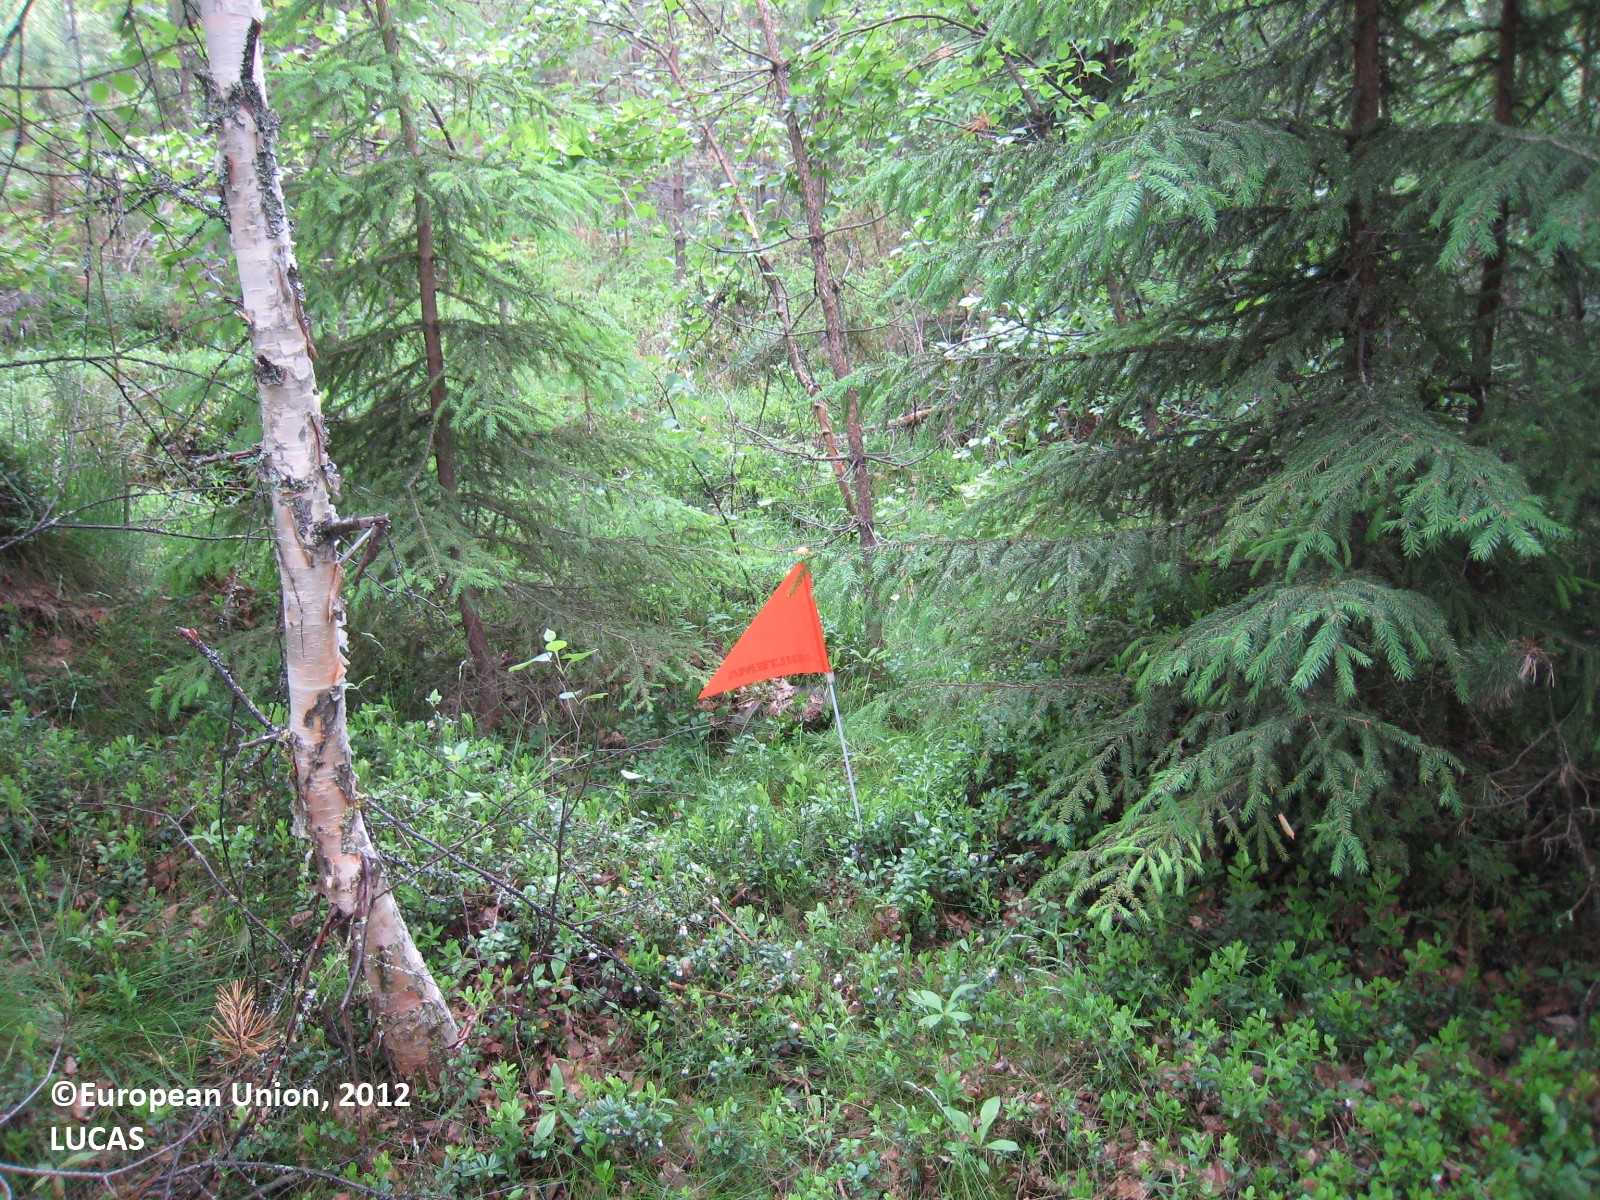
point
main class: Woodland
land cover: Other mixed woodland
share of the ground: > 75 %
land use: Forestry
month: June
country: FI
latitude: 62.1044
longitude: 26.2870
